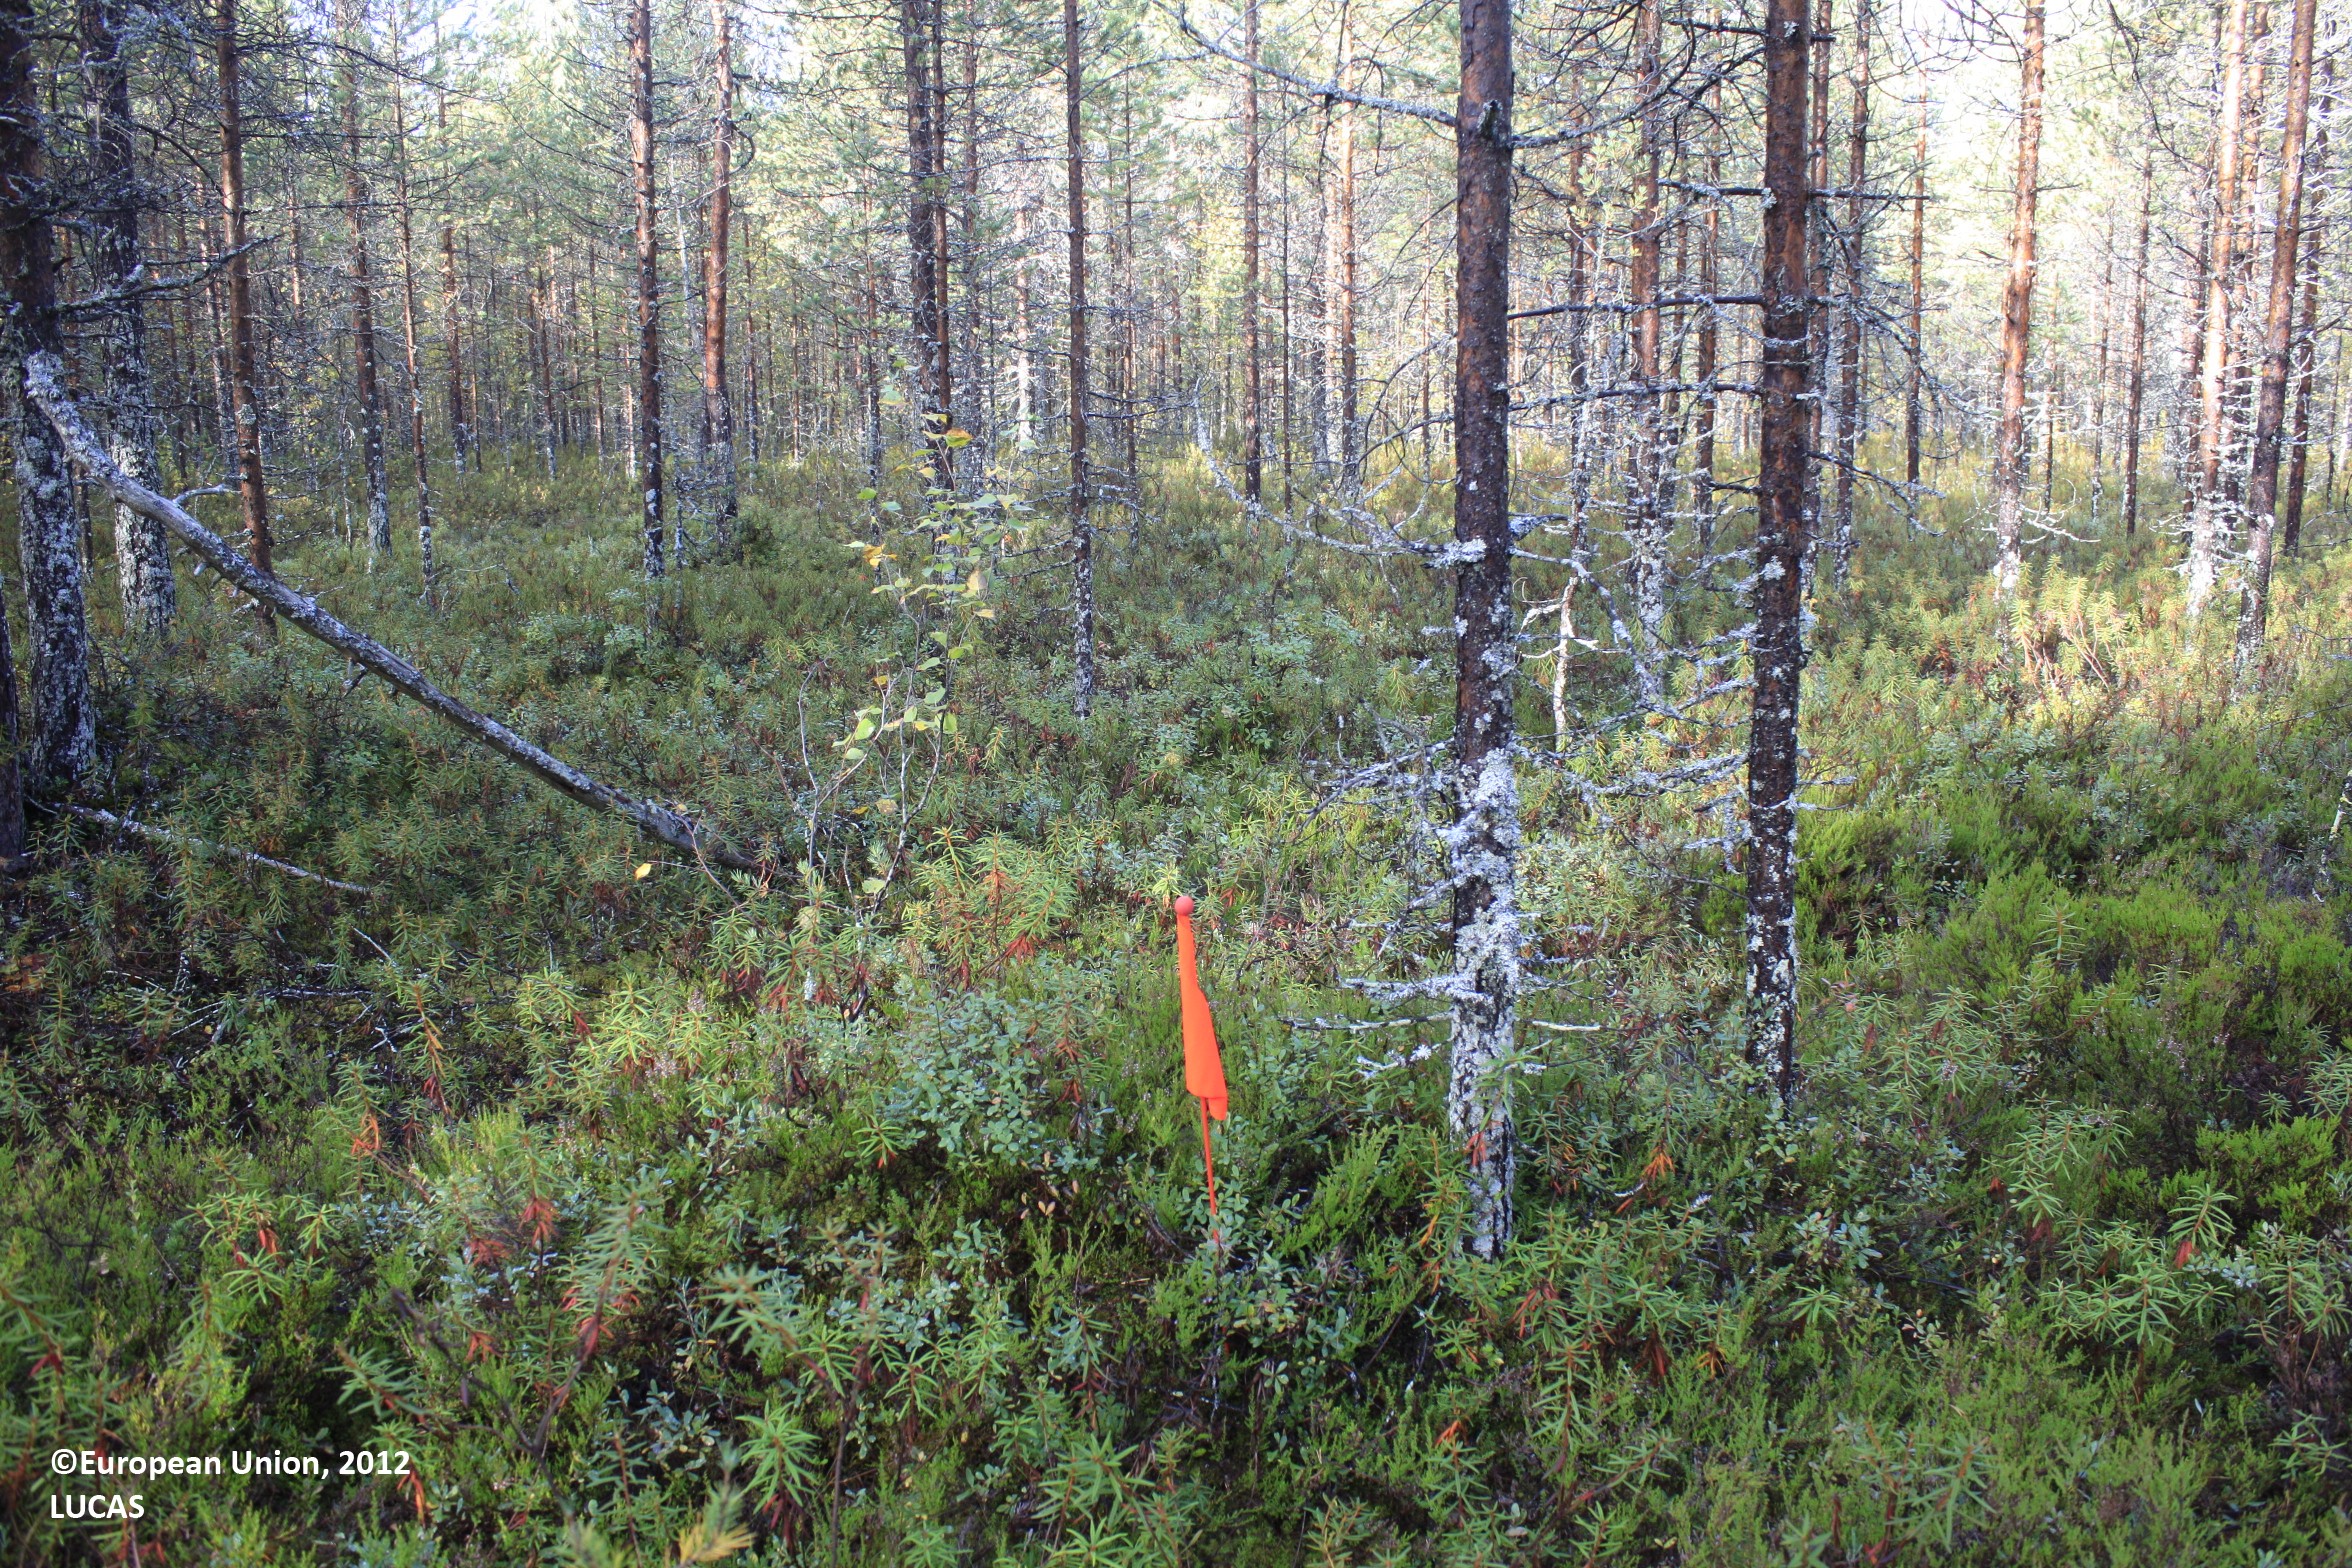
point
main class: Woodland
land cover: Pine dominated coniferous woodland
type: boreal forest
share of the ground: 25 - 50 %
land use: Forestry
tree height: > 5 m
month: September
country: FI
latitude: 65.2664
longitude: 27.0632
